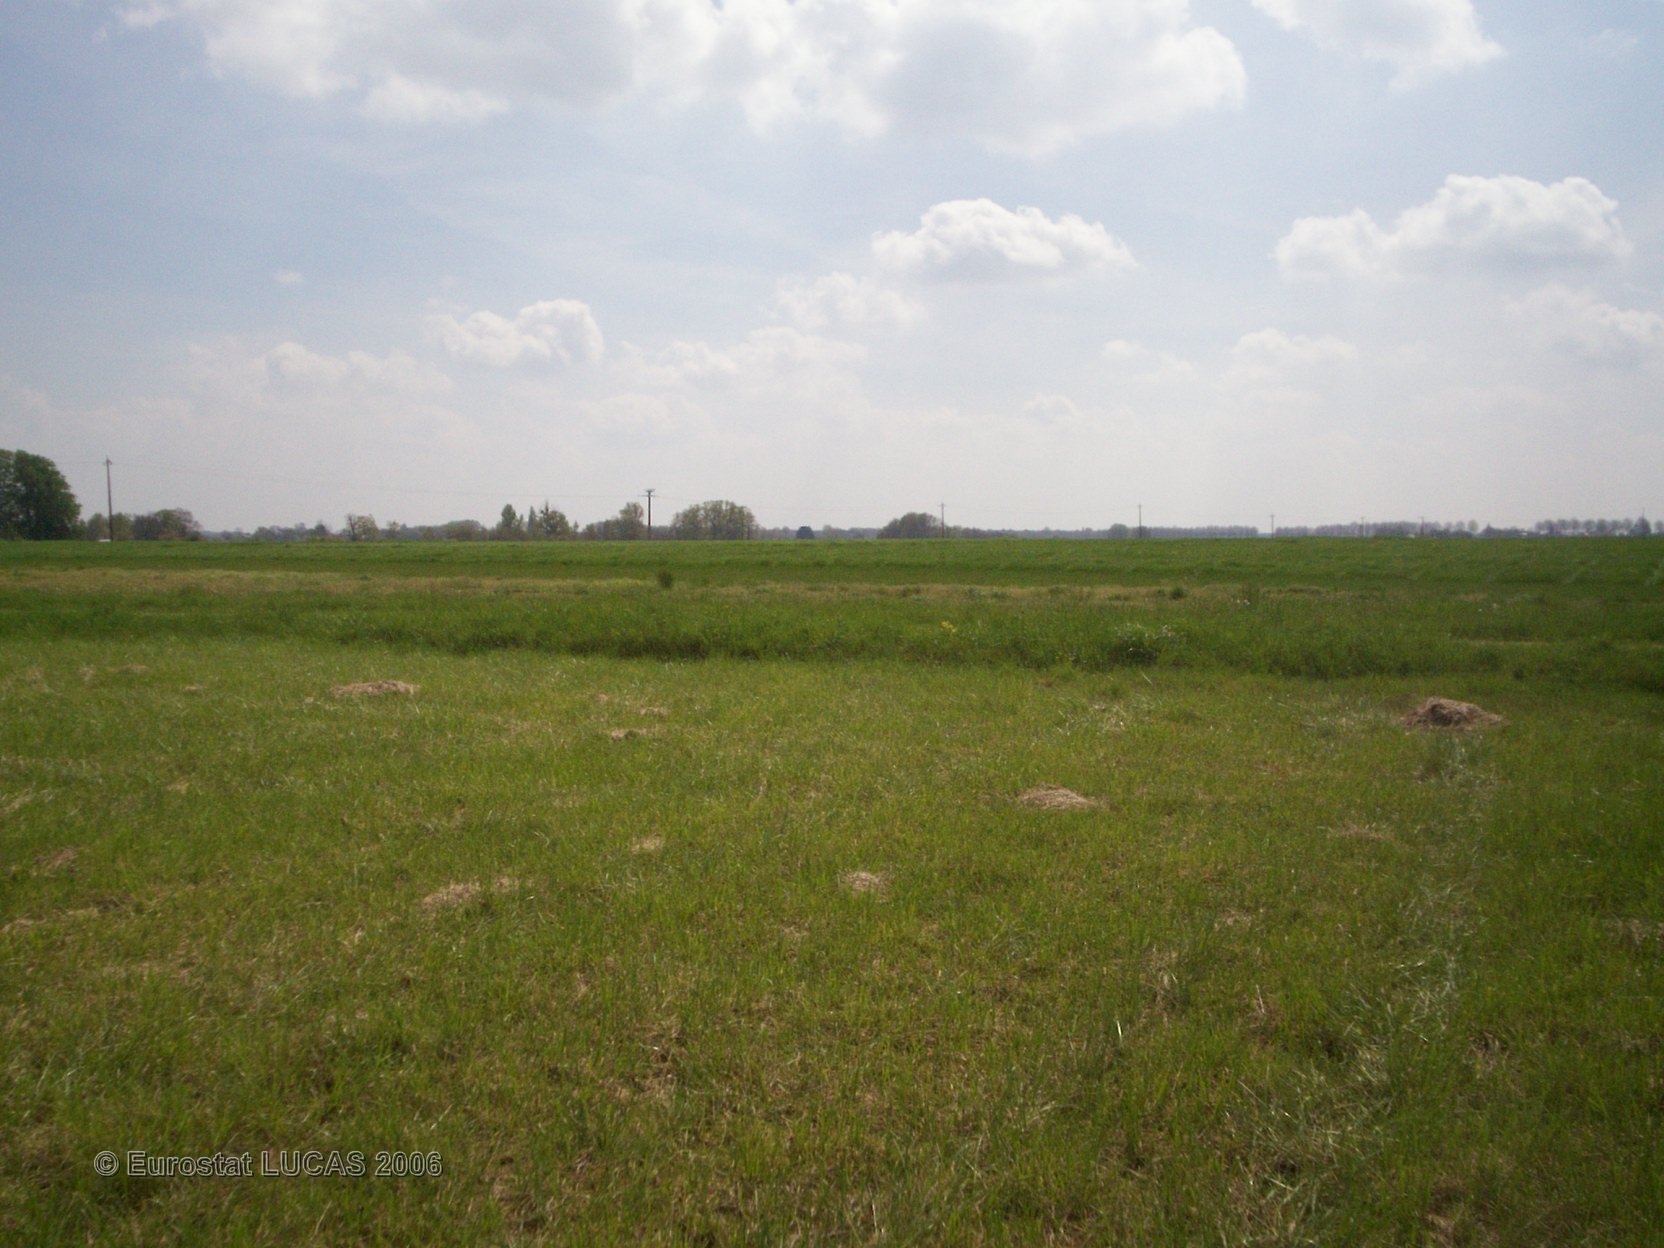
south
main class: Grassland
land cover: Grassland without tree/shrub cover
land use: Agriculture (excluding fallow land and kitchen gardens)
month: April
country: FR
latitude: 47.3320
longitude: -0.3907
